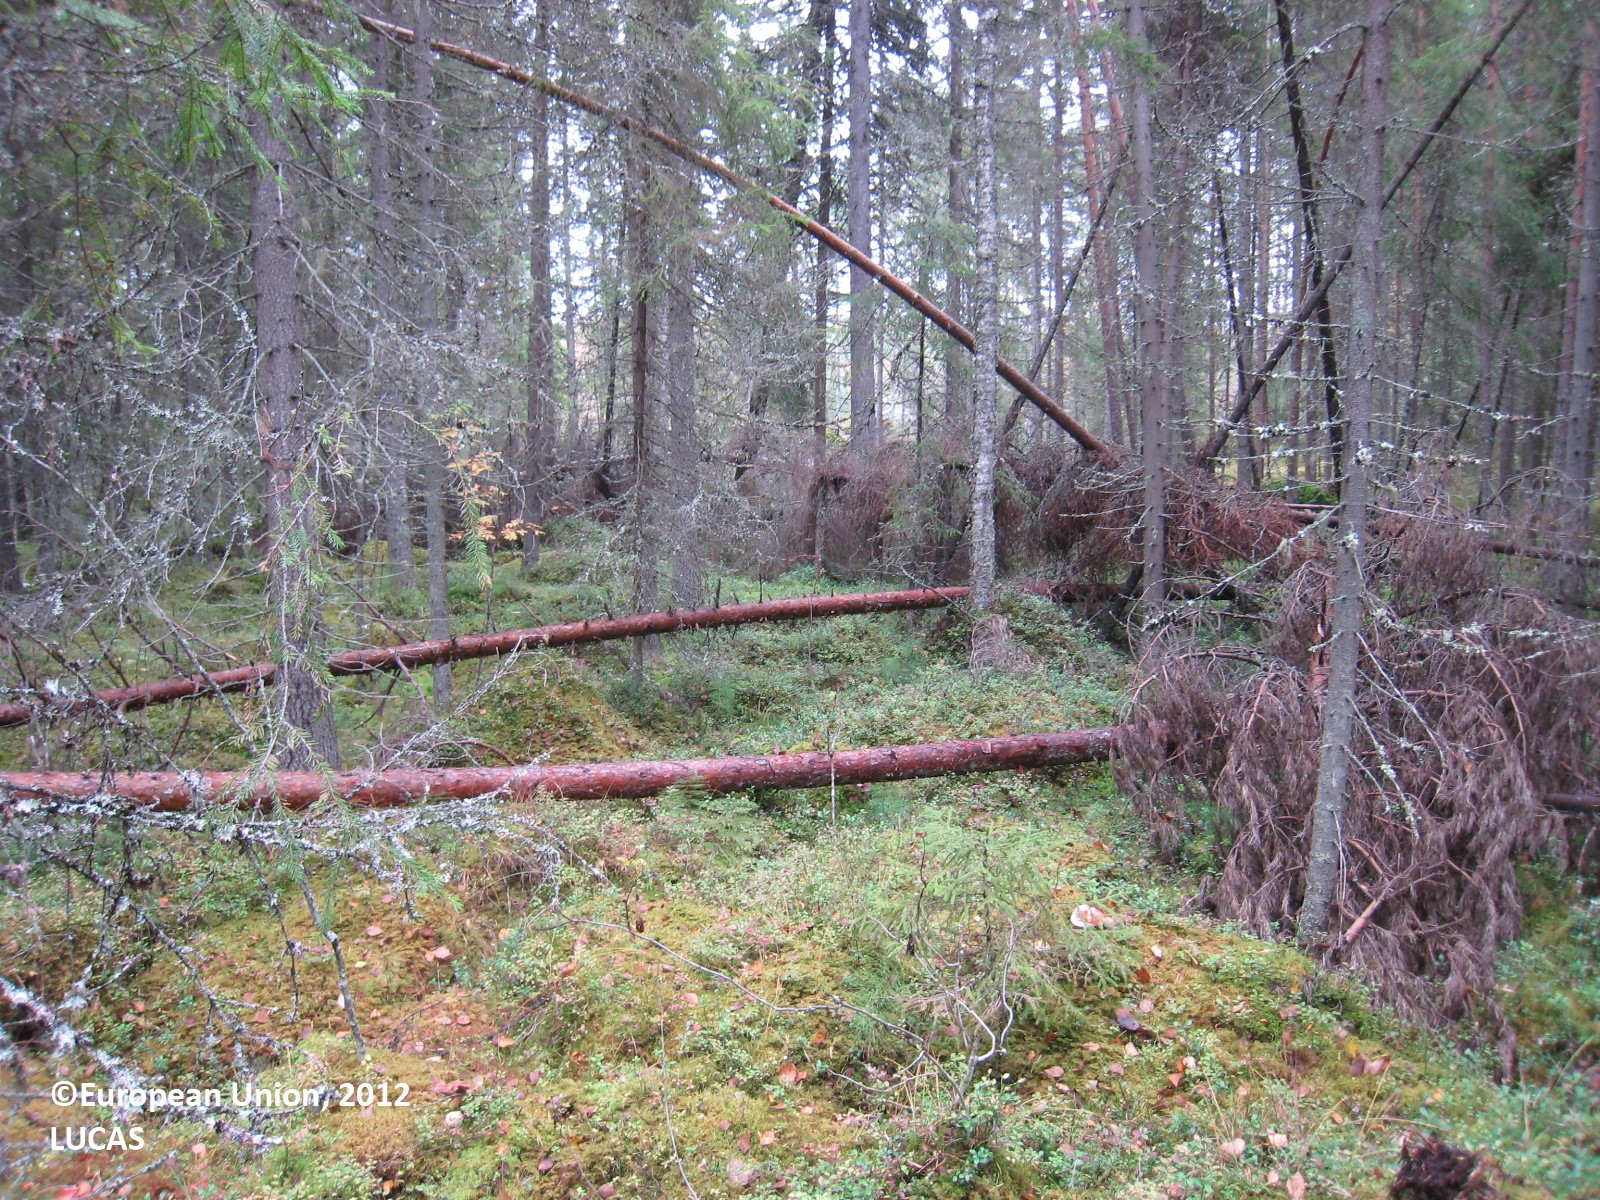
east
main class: Woodland
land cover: Other coniferous woodland
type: boreal forest
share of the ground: > 75 %
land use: Forestry
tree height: > 5 m
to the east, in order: Other coniferous woodland; Spruce dominated coniferous woodland; Spruce dominated mixed woodland; Other mixed woodland; Ditches and canals; Managed hedges; Tracks; Shruby margins; Ditches and canals; Spruce dominated mixed woodland; Ditches and canals; Spruce dominated mixed woodland; Ditches and canals; Spruce dominated mixed woodland; Ditches and canals; Spruce dominated mixed woodland; Ditches and canals; Spruce dominated mixed woodland; Ditches and canals; Spruce dominated mixed woodland; Ditches and canals; Spruce dominated mixed woodland; Ditches and canals; Grassland with sparse tree/shrub cover; Ditches and canals; Other mixed woodland
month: September
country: FI
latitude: 62.7258
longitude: 26.1859
